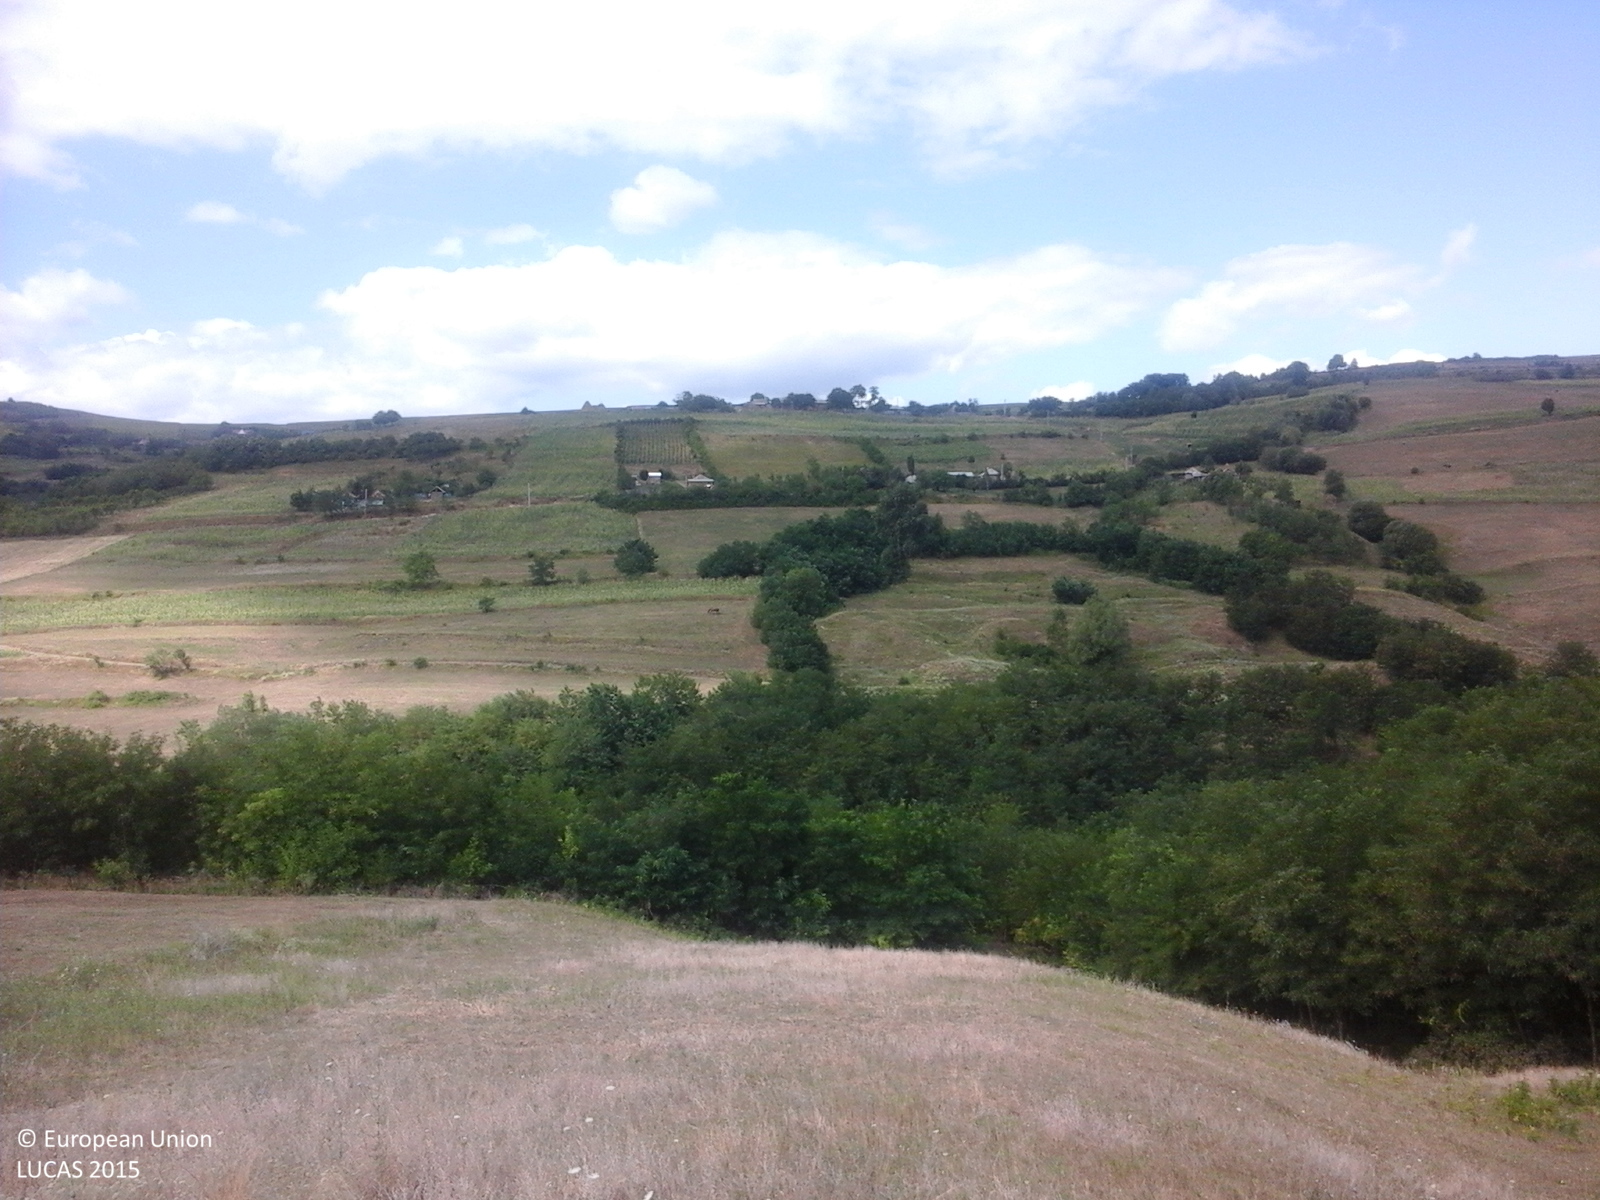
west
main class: Grassland
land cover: Grassland without tree/shrub cover
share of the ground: > 75 %
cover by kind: herbaceous plants 100 %
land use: Agriculture (excluding fallow land and kitchen gardens)
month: July
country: RO
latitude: 46.4289
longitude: 27.3482
